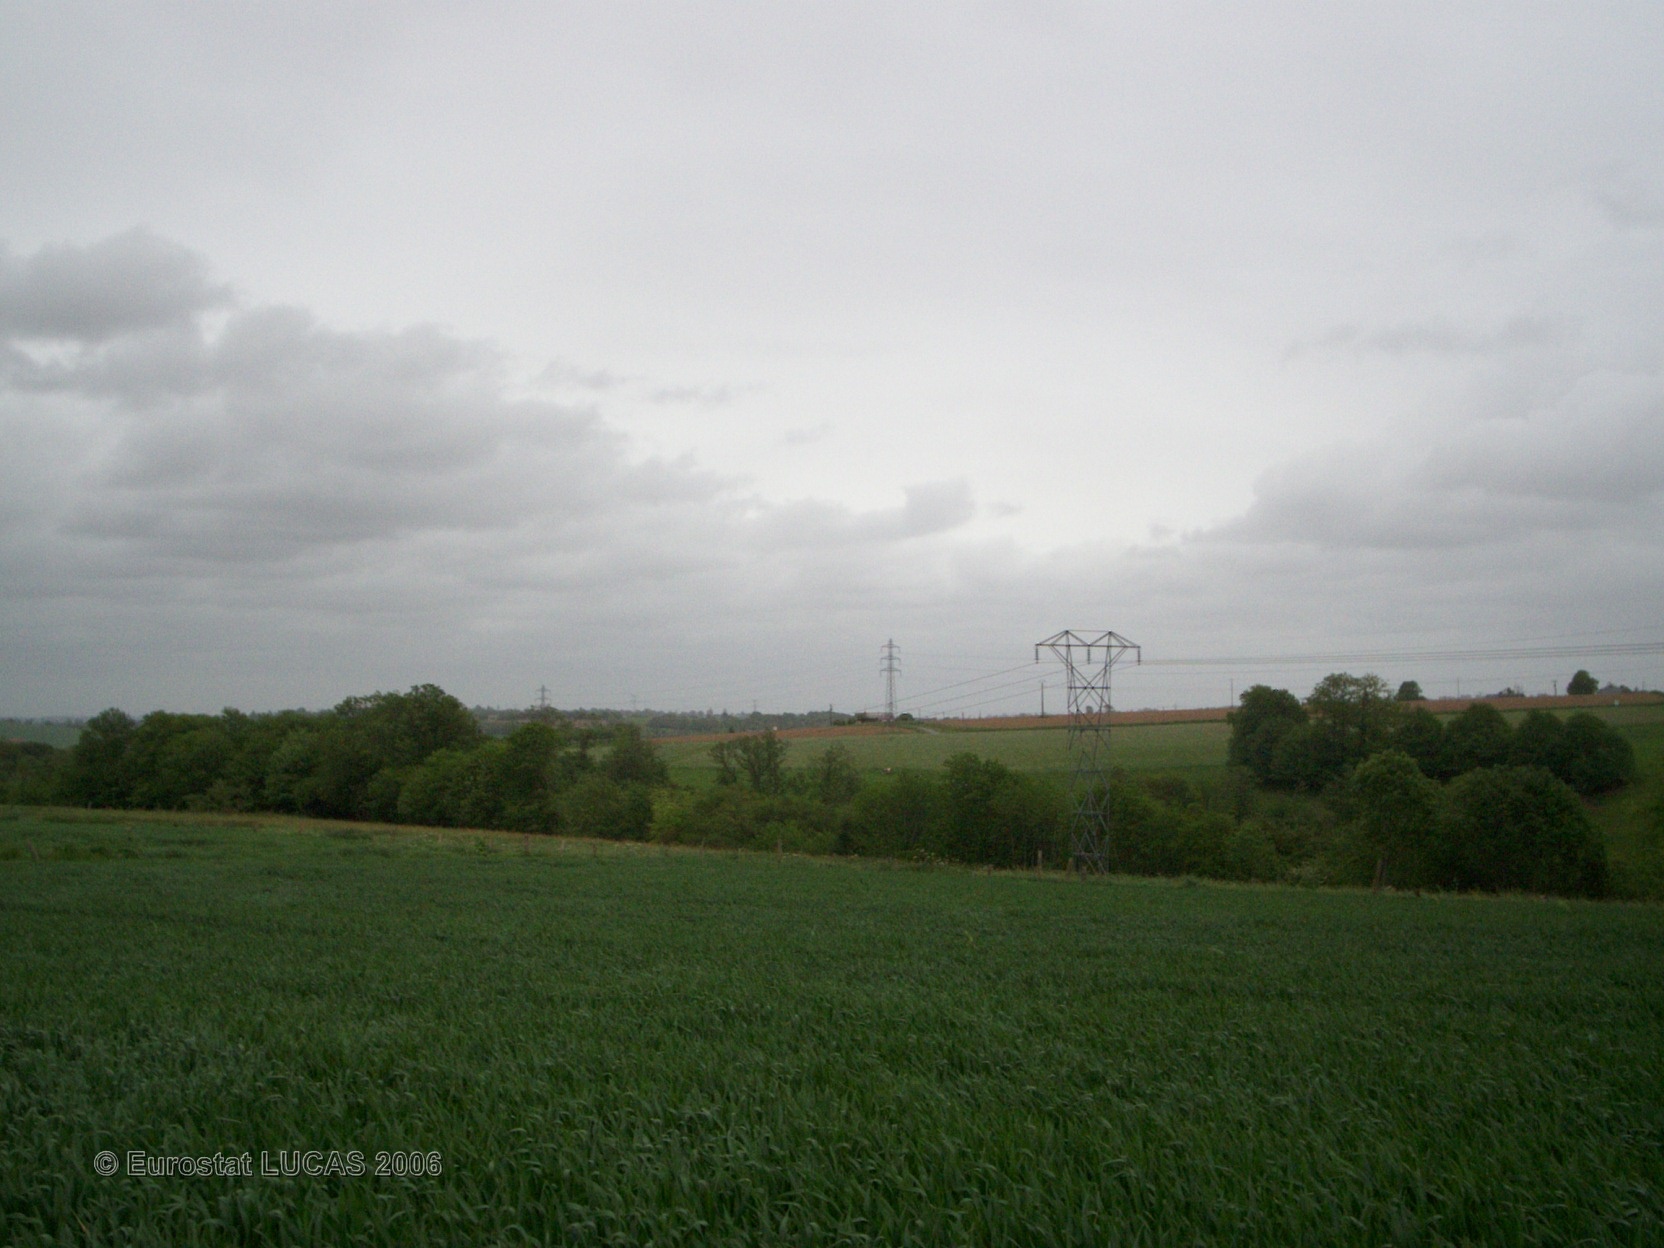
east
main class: Cropland
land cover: Common wheat
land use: Agriculture (excluding fallow land and kitchen gardens)
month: May
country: FR
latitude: 48.5719
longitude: -1.2523
